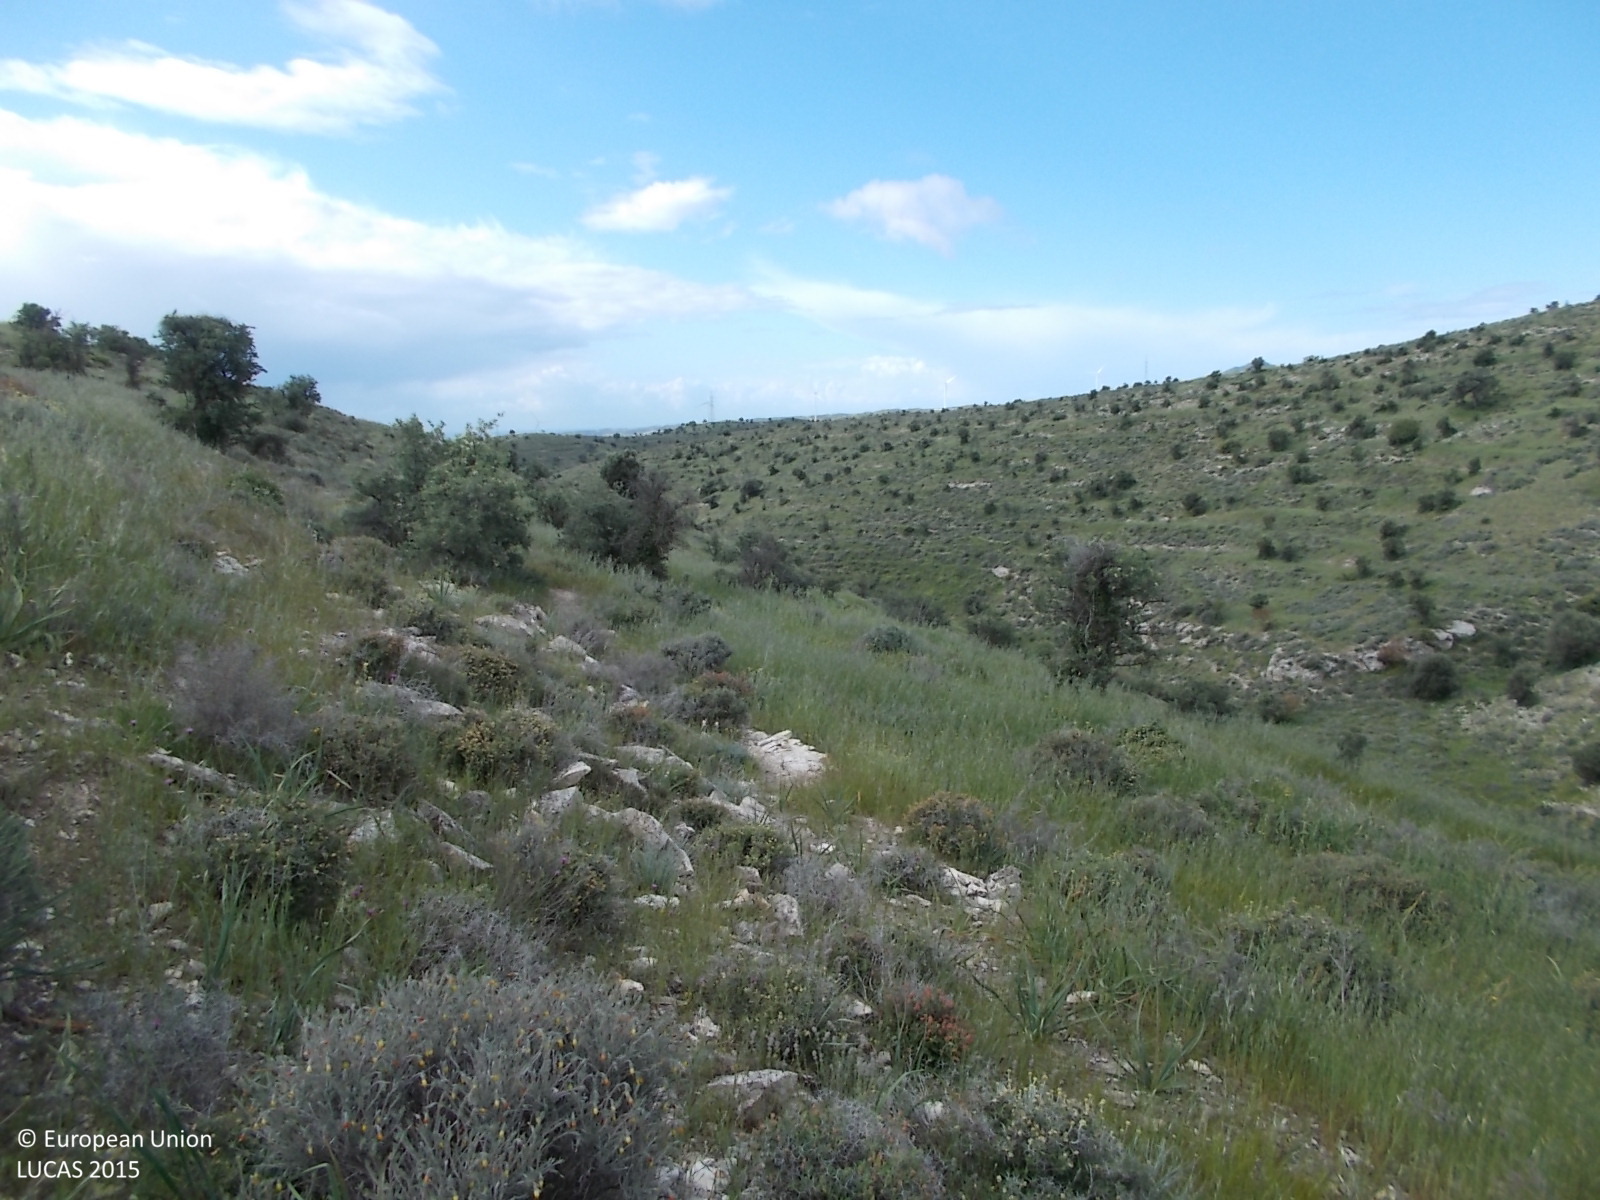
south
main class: Shrubland
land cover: Shrubland without tree cover
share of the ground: 50 - 75 %
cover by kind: shrubs 60 %, unconsolidated bare surface 30 %, herbaceous plants 10 %
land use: Semi-natural and natural areas not in use
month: April
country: CY
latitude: 34.9680
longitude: 33.4883
